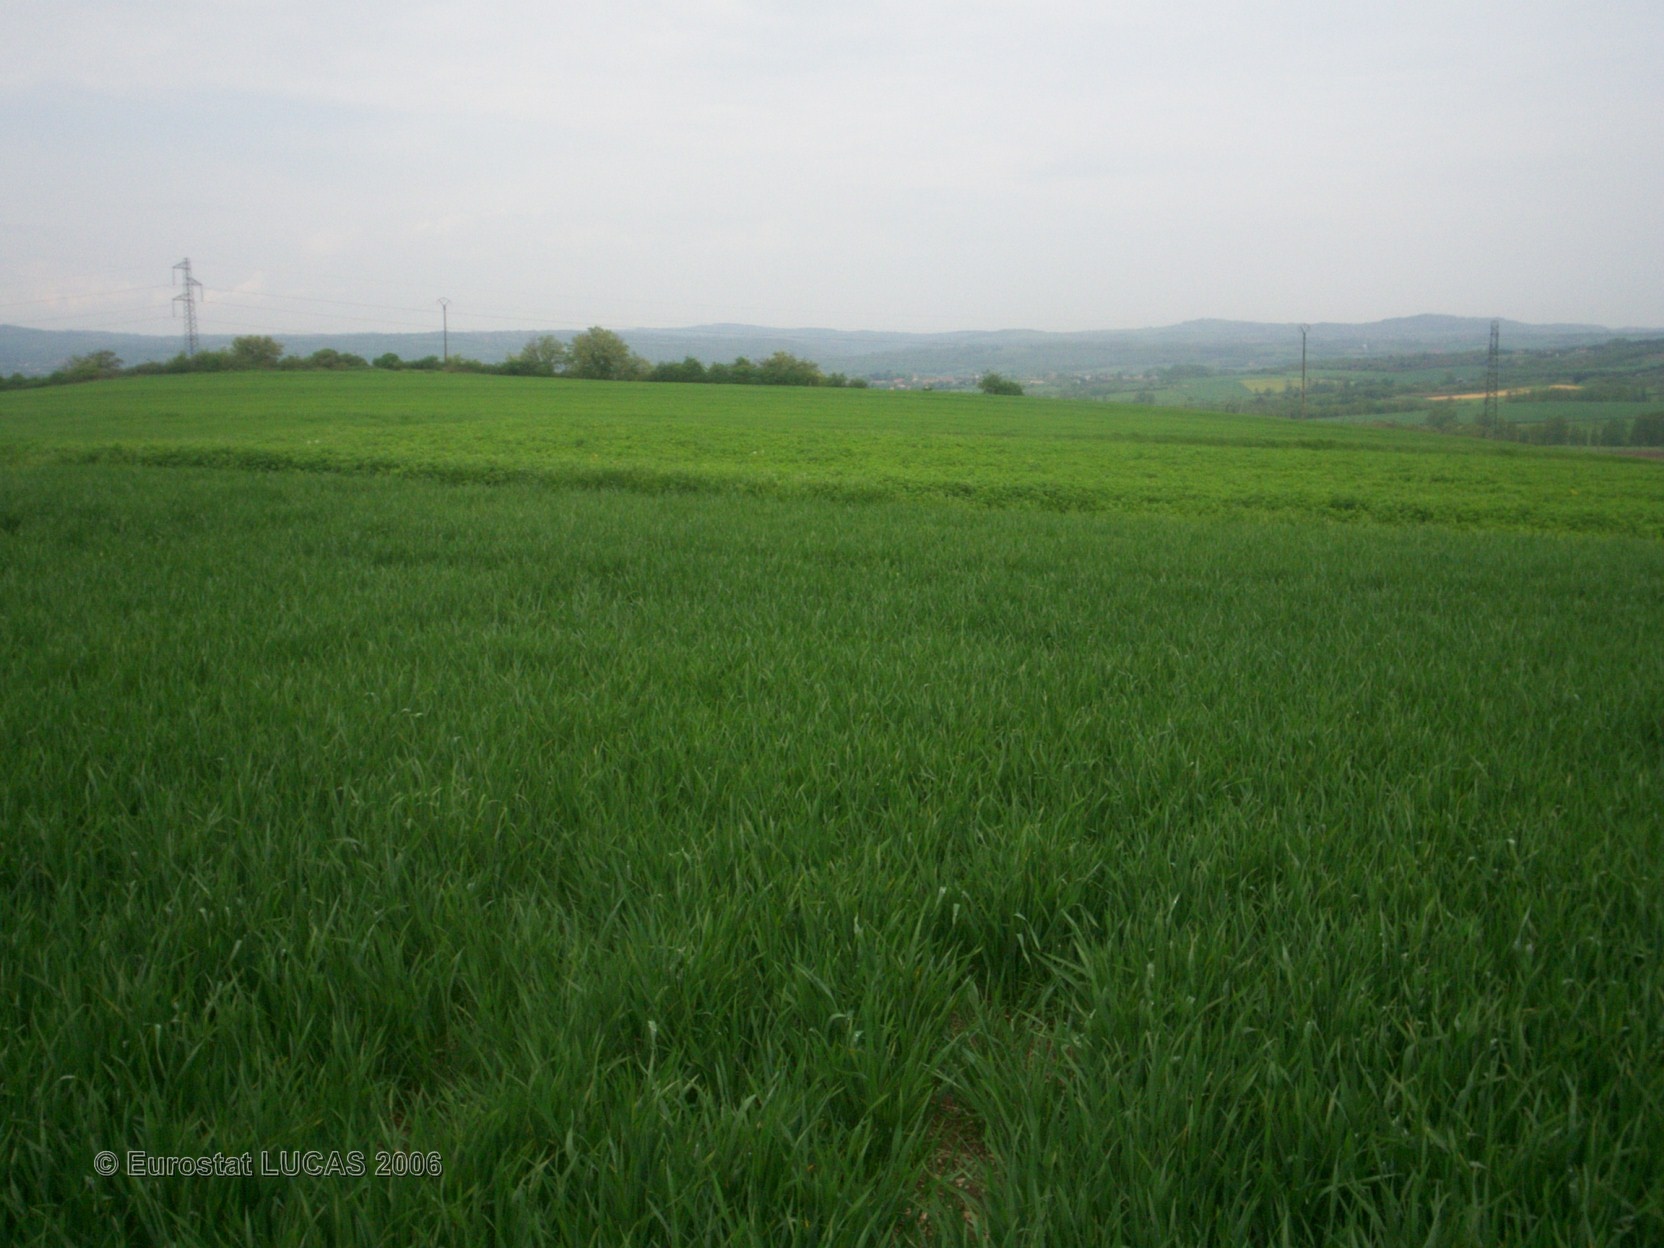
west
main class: Cropland
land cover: Common wheat
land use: Agriculture (excluding fallow land and kitchen gardens)
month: May
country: FR
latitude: 46.0224
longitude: 3.1398
